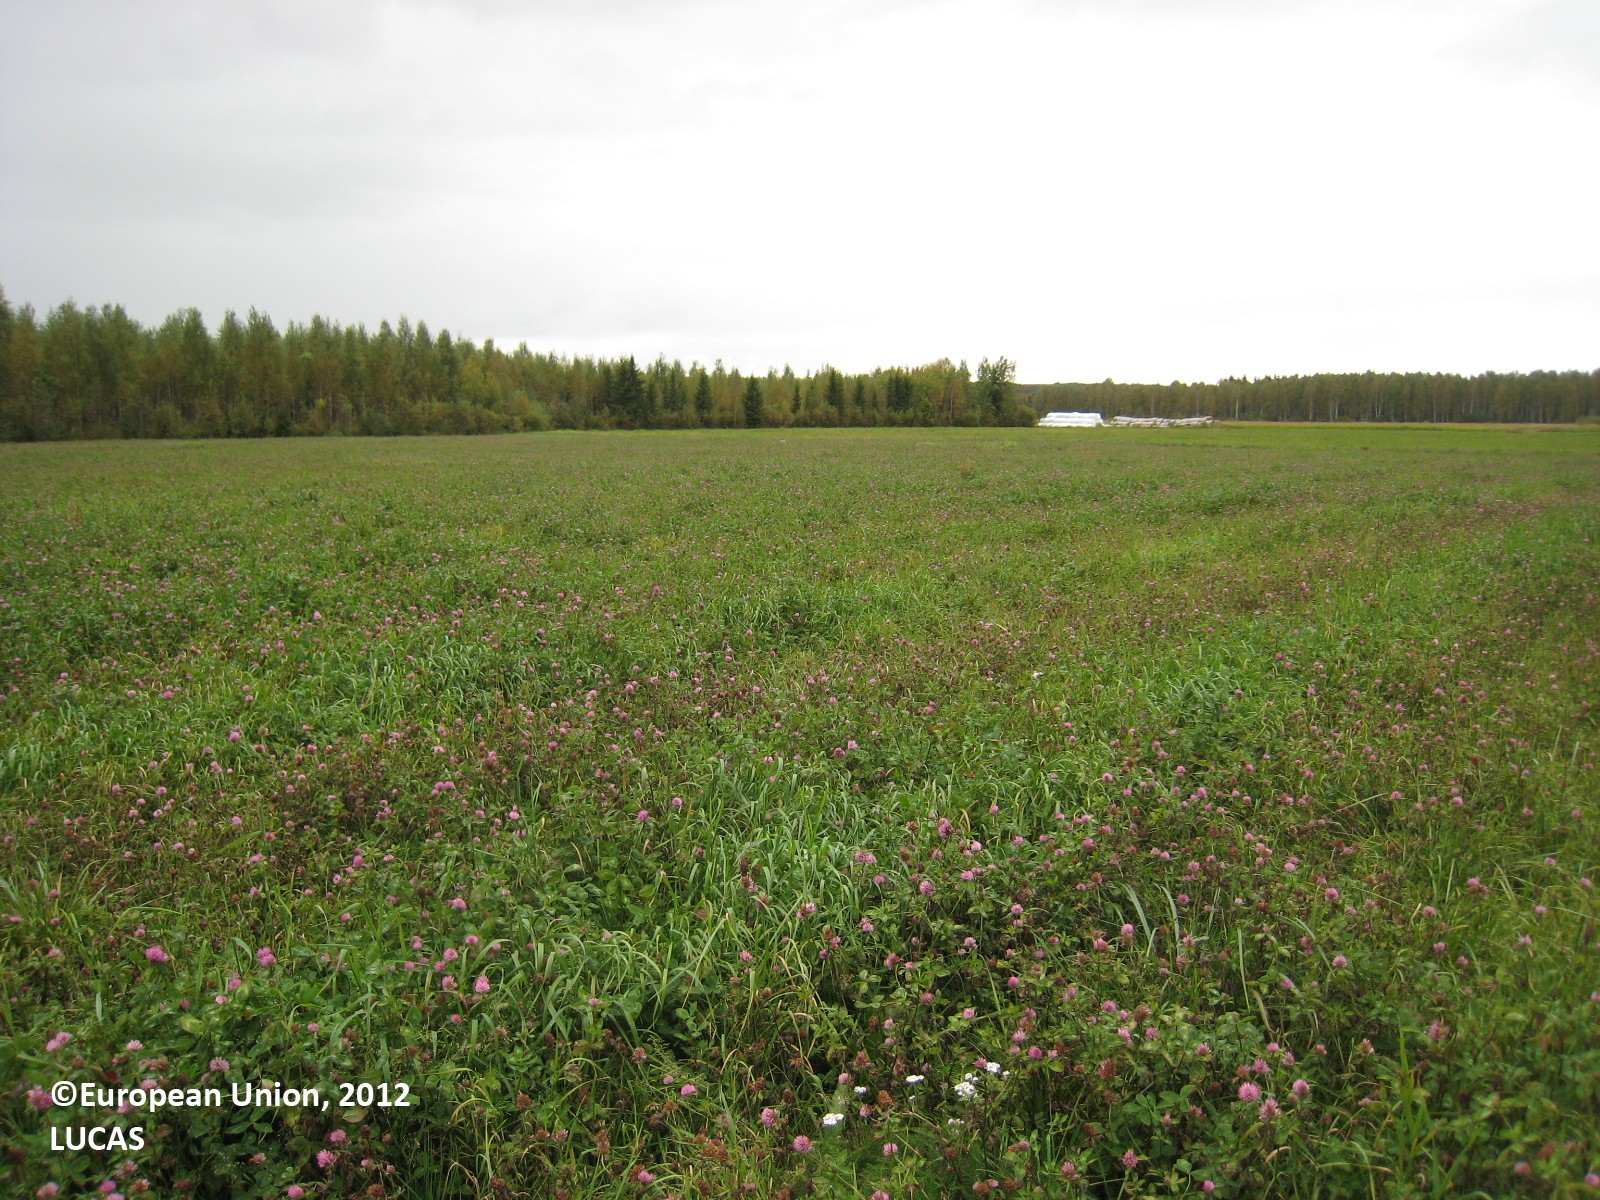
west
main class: Cropland
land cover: Clovers
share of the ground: > 75 %
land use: Fallow land
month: September
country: FI
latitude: 63.0750
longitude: 26.3793
